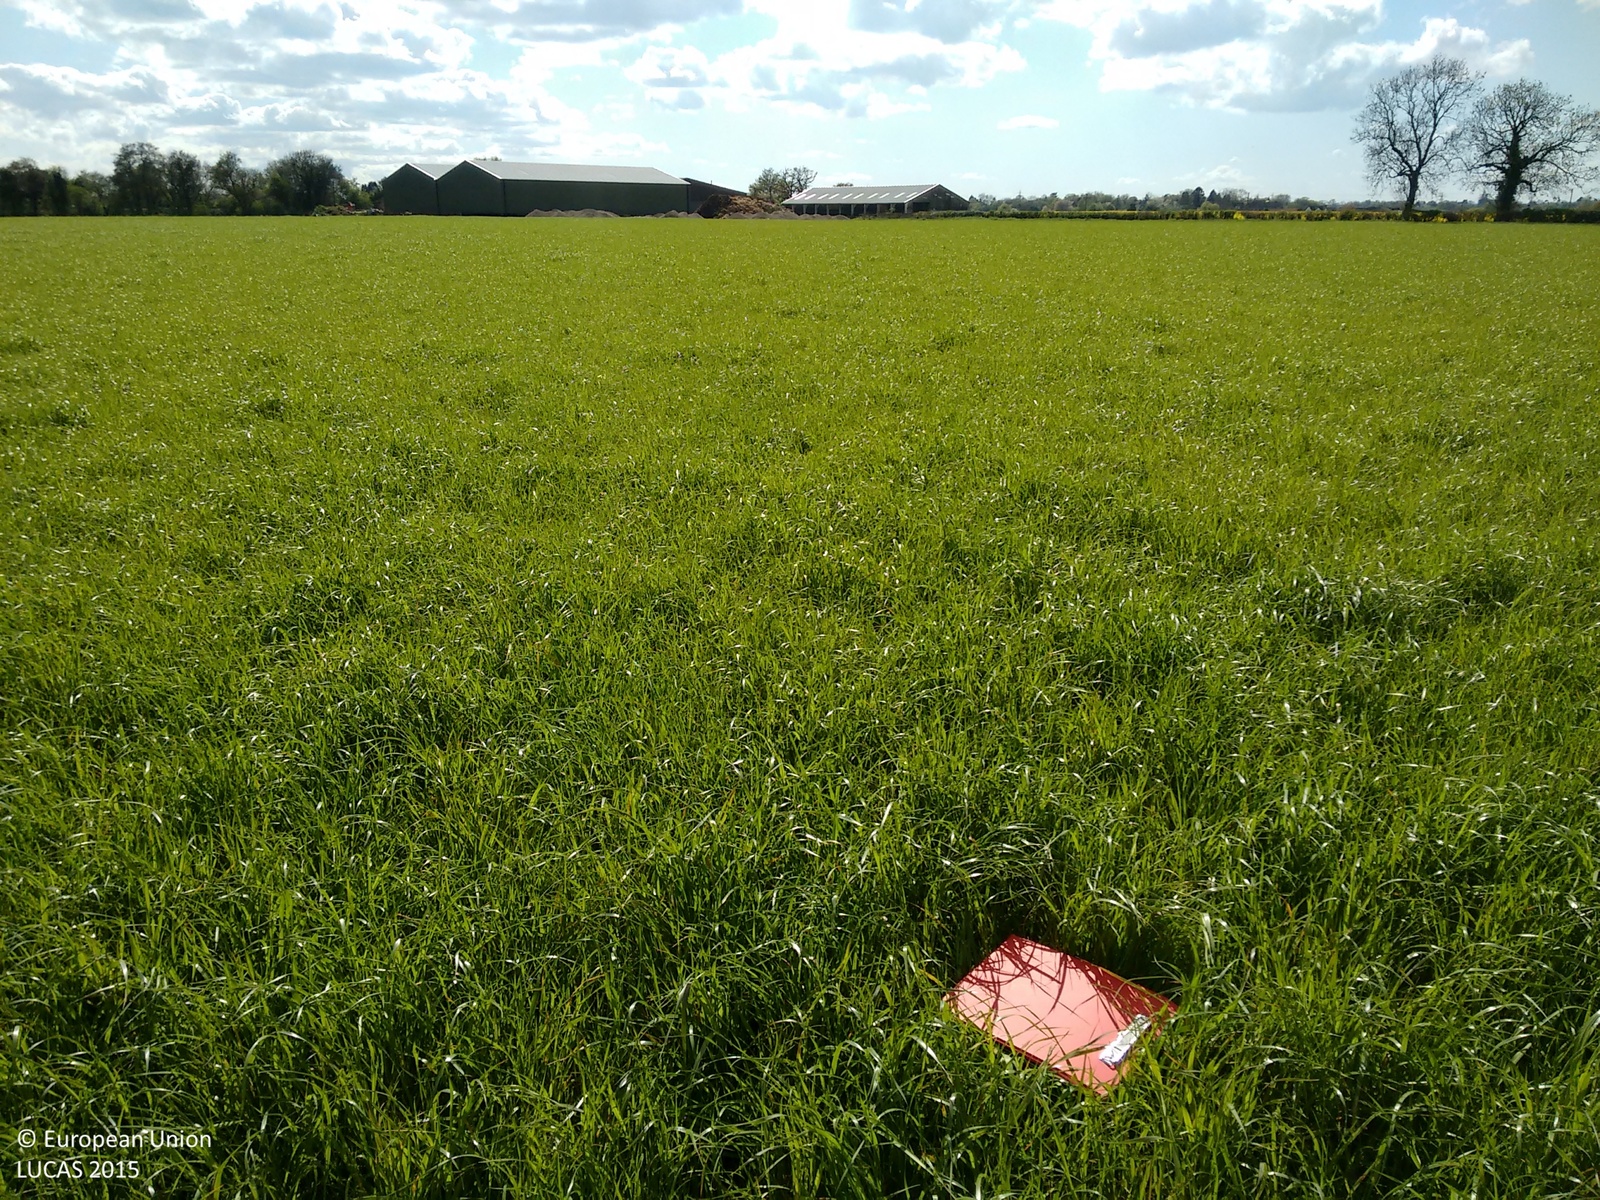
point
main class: Cropland
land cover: Common wheat
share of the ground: > 75 %
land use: Agriculture (excluding fallow land and kitchen gardens)
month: April
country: GB
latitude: 51.7234
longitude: -0.5636
